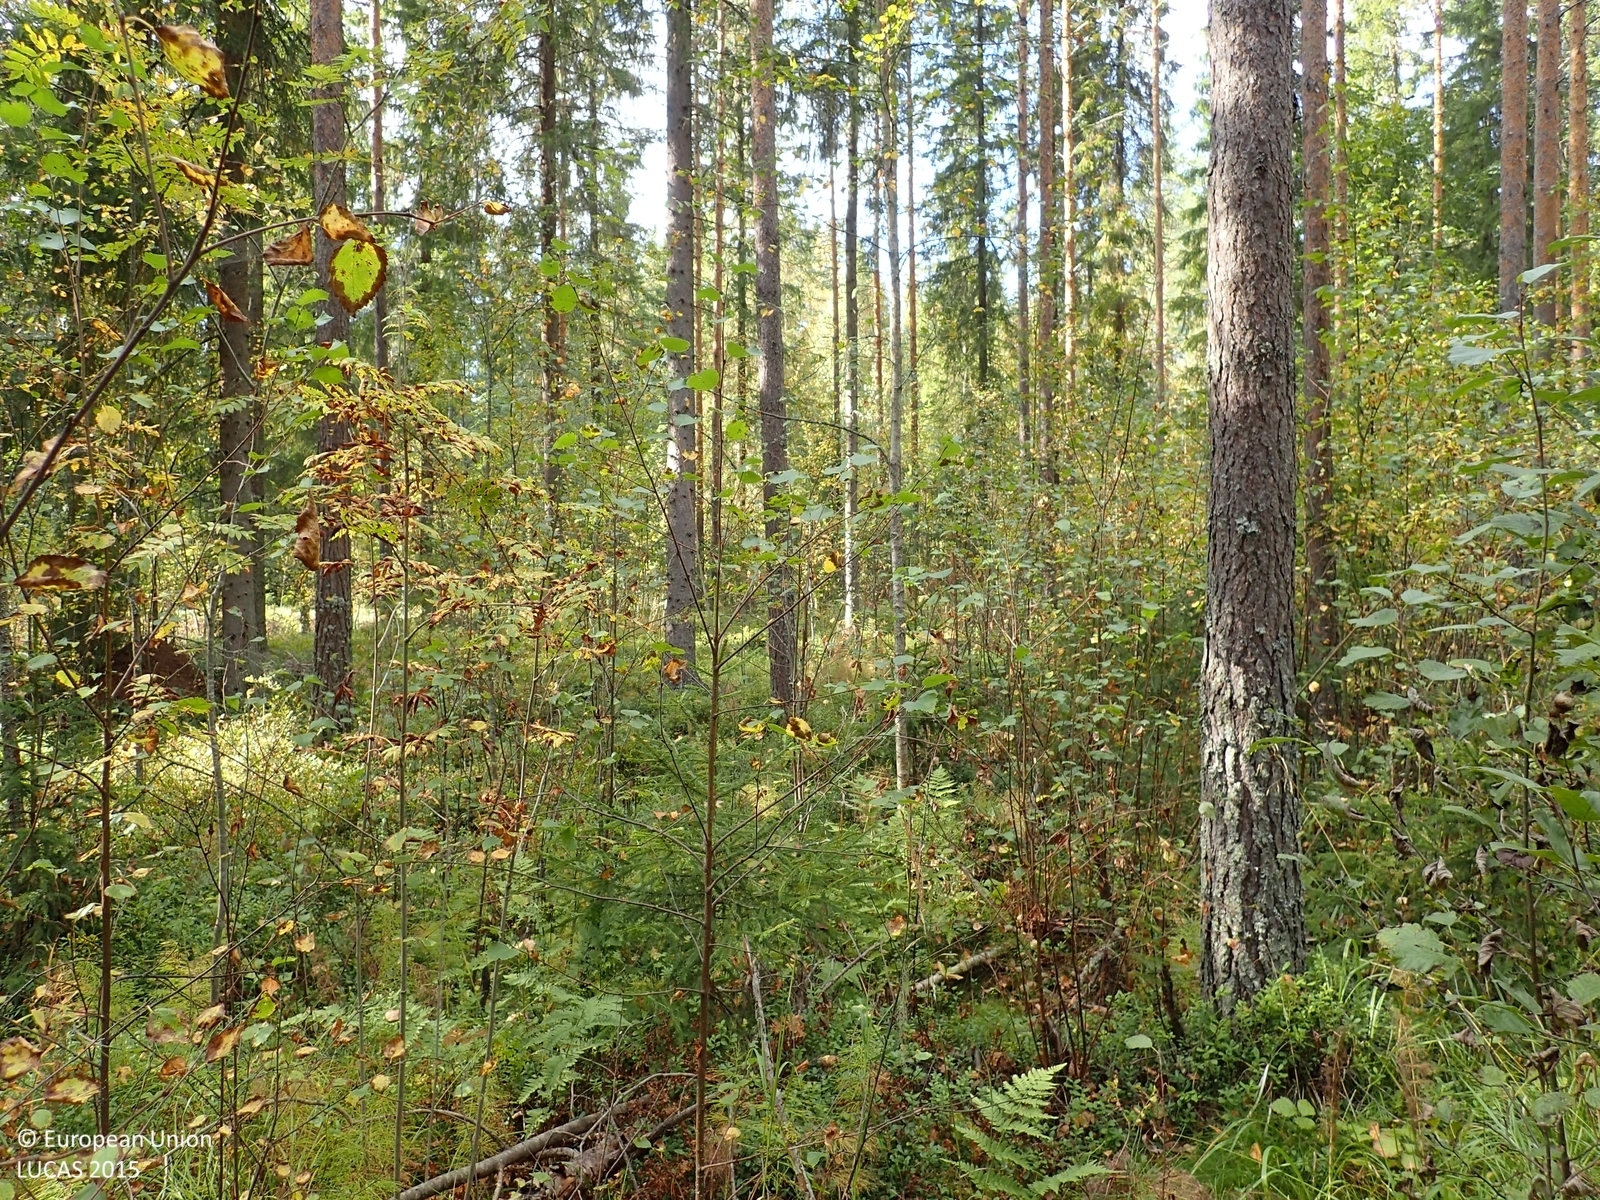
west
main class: Woodland
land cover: Pine dominated mixed woodland
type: boreal forest
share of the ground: > 75 %
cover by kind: coniferous forest trees 55 %, broadleaved forest trees 20 %, herbaceous plants 15 %, shrubs 10 %
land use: Forestry
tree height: > 5 m
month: September
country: FI
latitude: 63.0362
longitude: 25.3439
